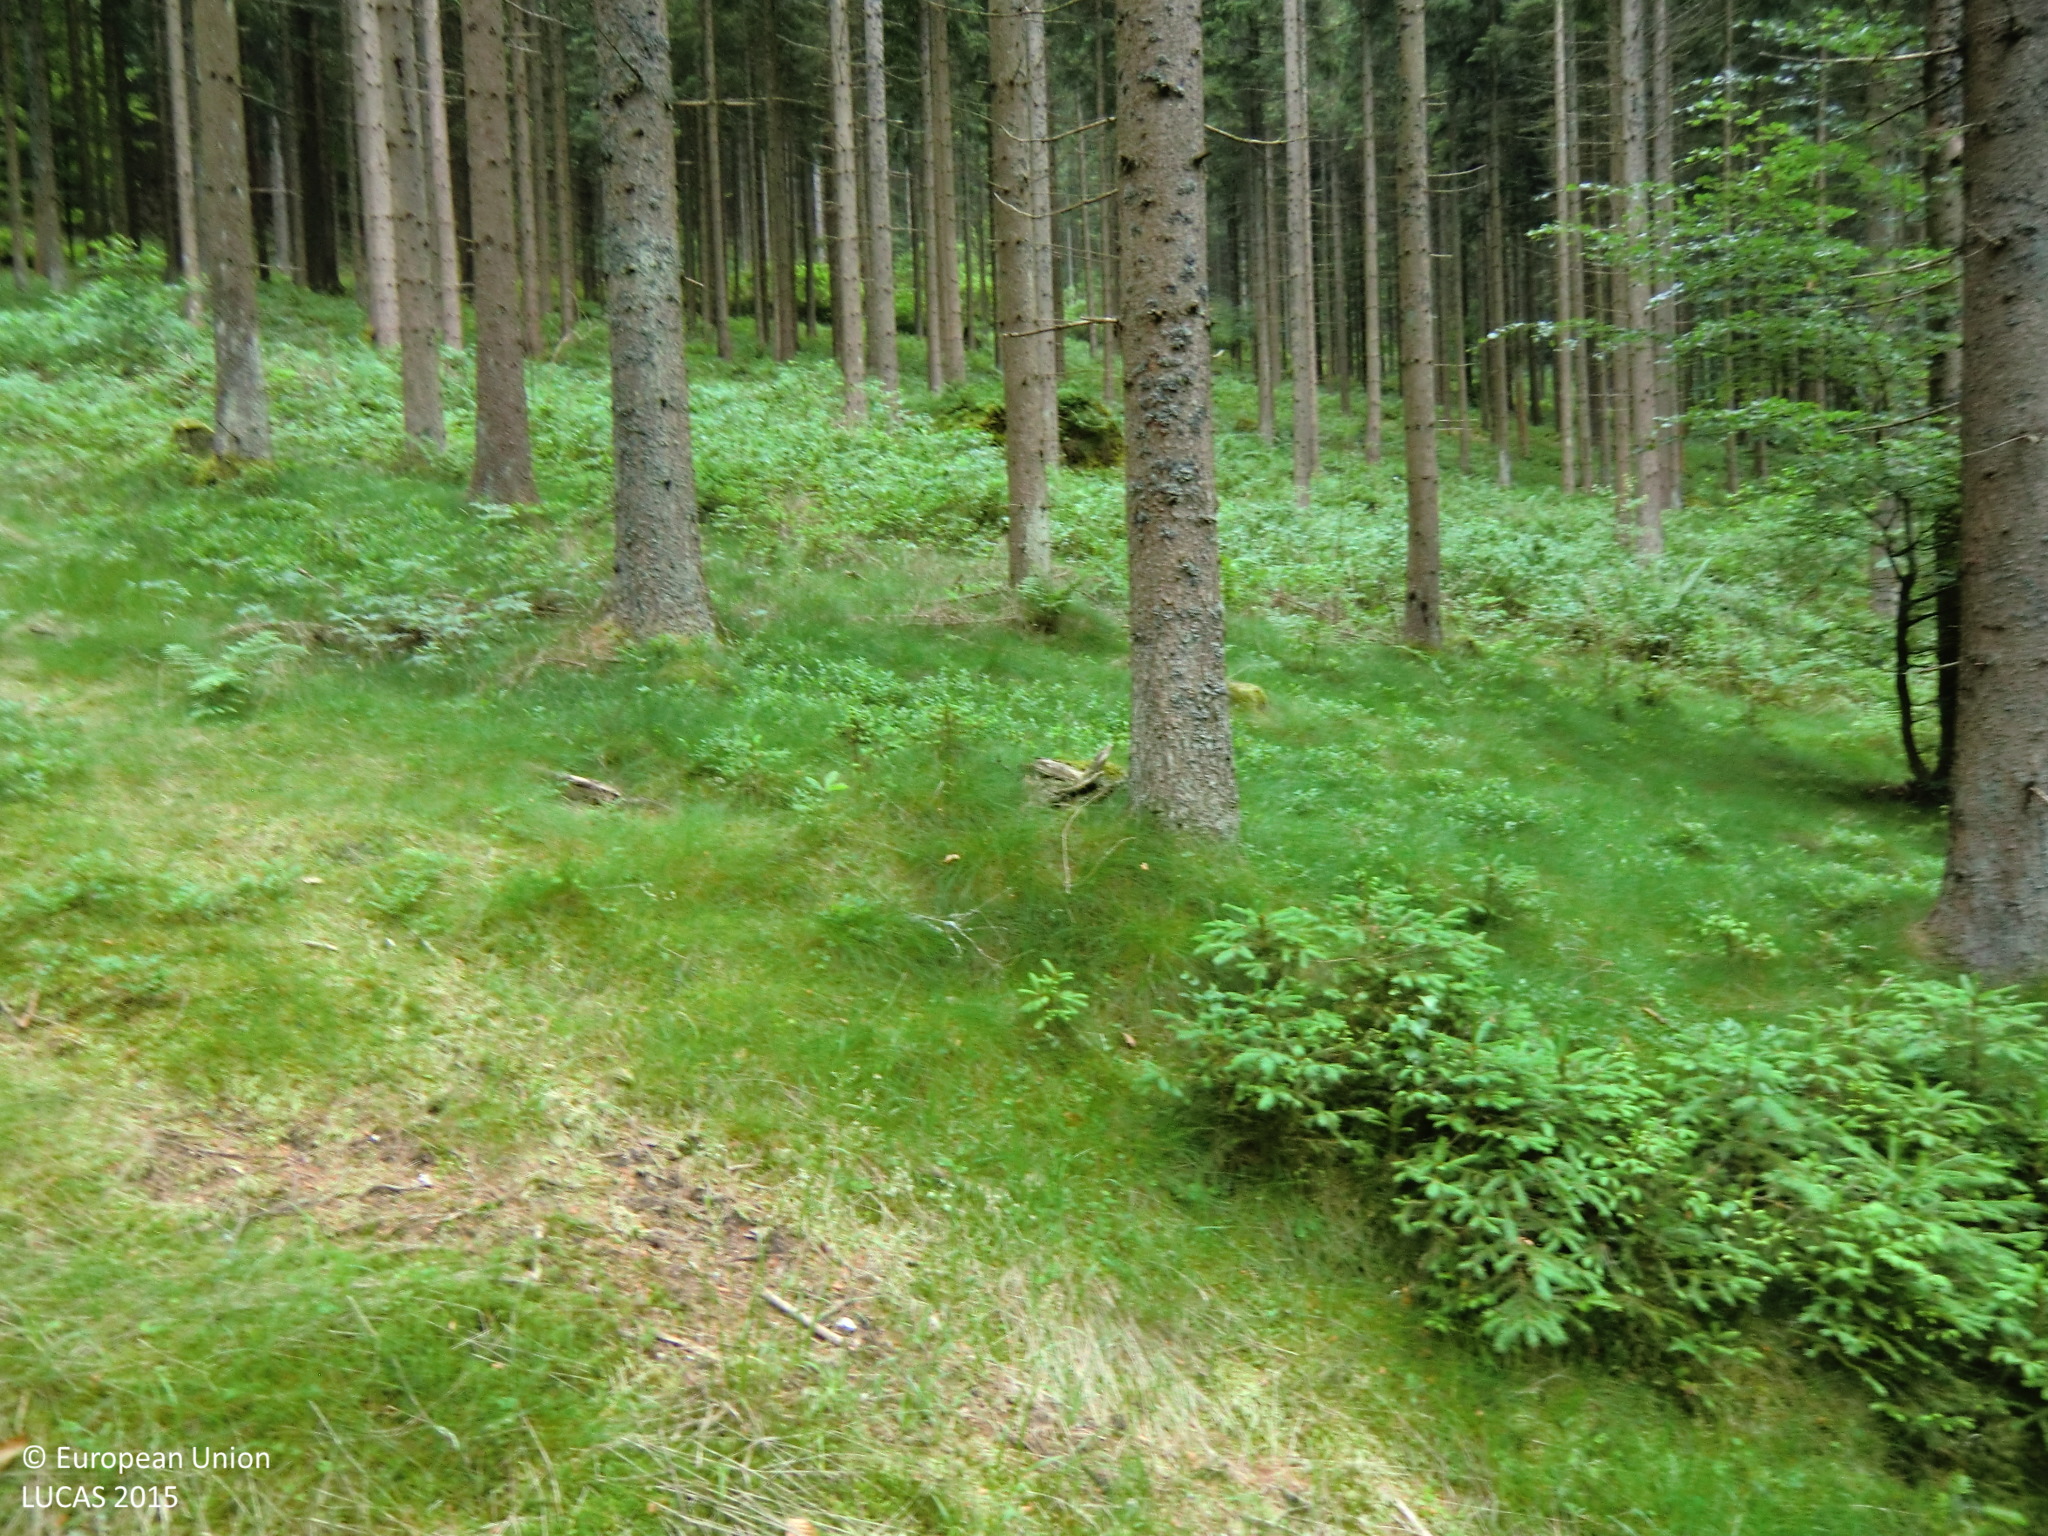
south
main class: Woodland
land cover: Spruce dominated coniferous woodland
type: hemiboreal forest and nemoral coniferous forest and mixed broadleaved-coniferous forest
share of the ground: 50 - 75 %
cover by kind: coniferous forest trees 60 %, shrubs 15 %, herbaceous plants 15 %, lichens and mosses 10 %
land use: Forestry
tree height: > 5 m
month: June
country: AT
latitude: 48.3693
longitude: 14.8473
